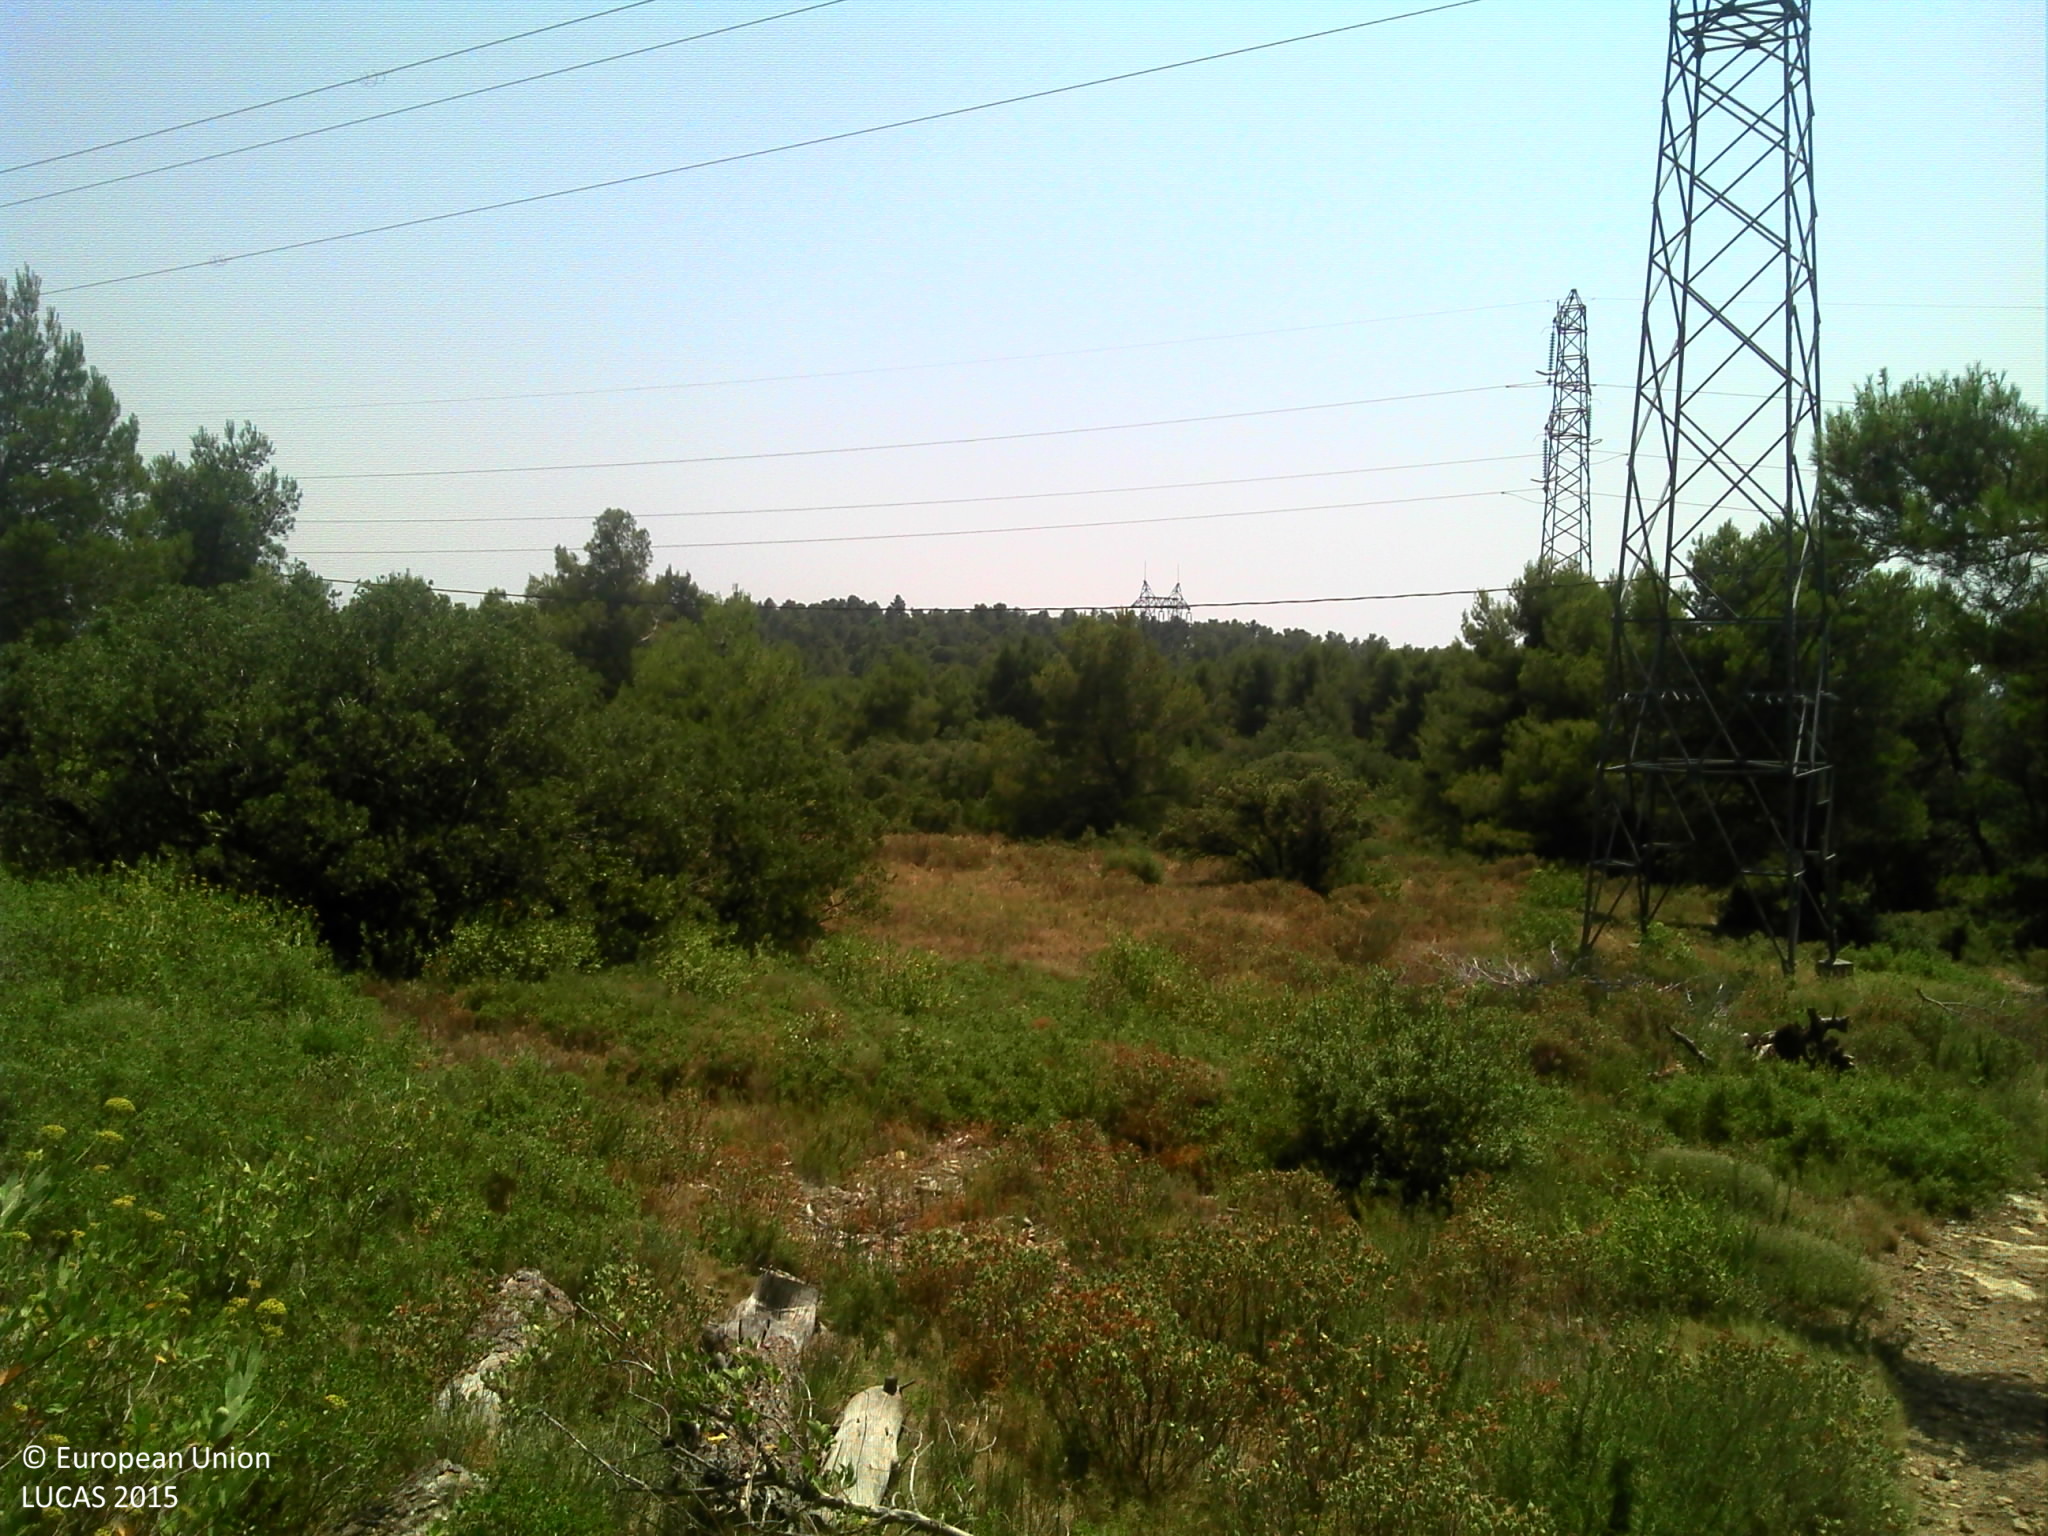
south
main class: Woodland
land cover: Pine dominated mixed woodland
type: broadleaved evergreen forest
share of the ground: > 75 %
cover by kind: shrubs 35 %, broadleaved forest trees 20 %, herbaceous plants 20 %, coniferous forest trees 15 %
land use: Forestry
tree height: > 5 m
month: July
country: FR
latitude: 43.6583
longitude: 5.1363
